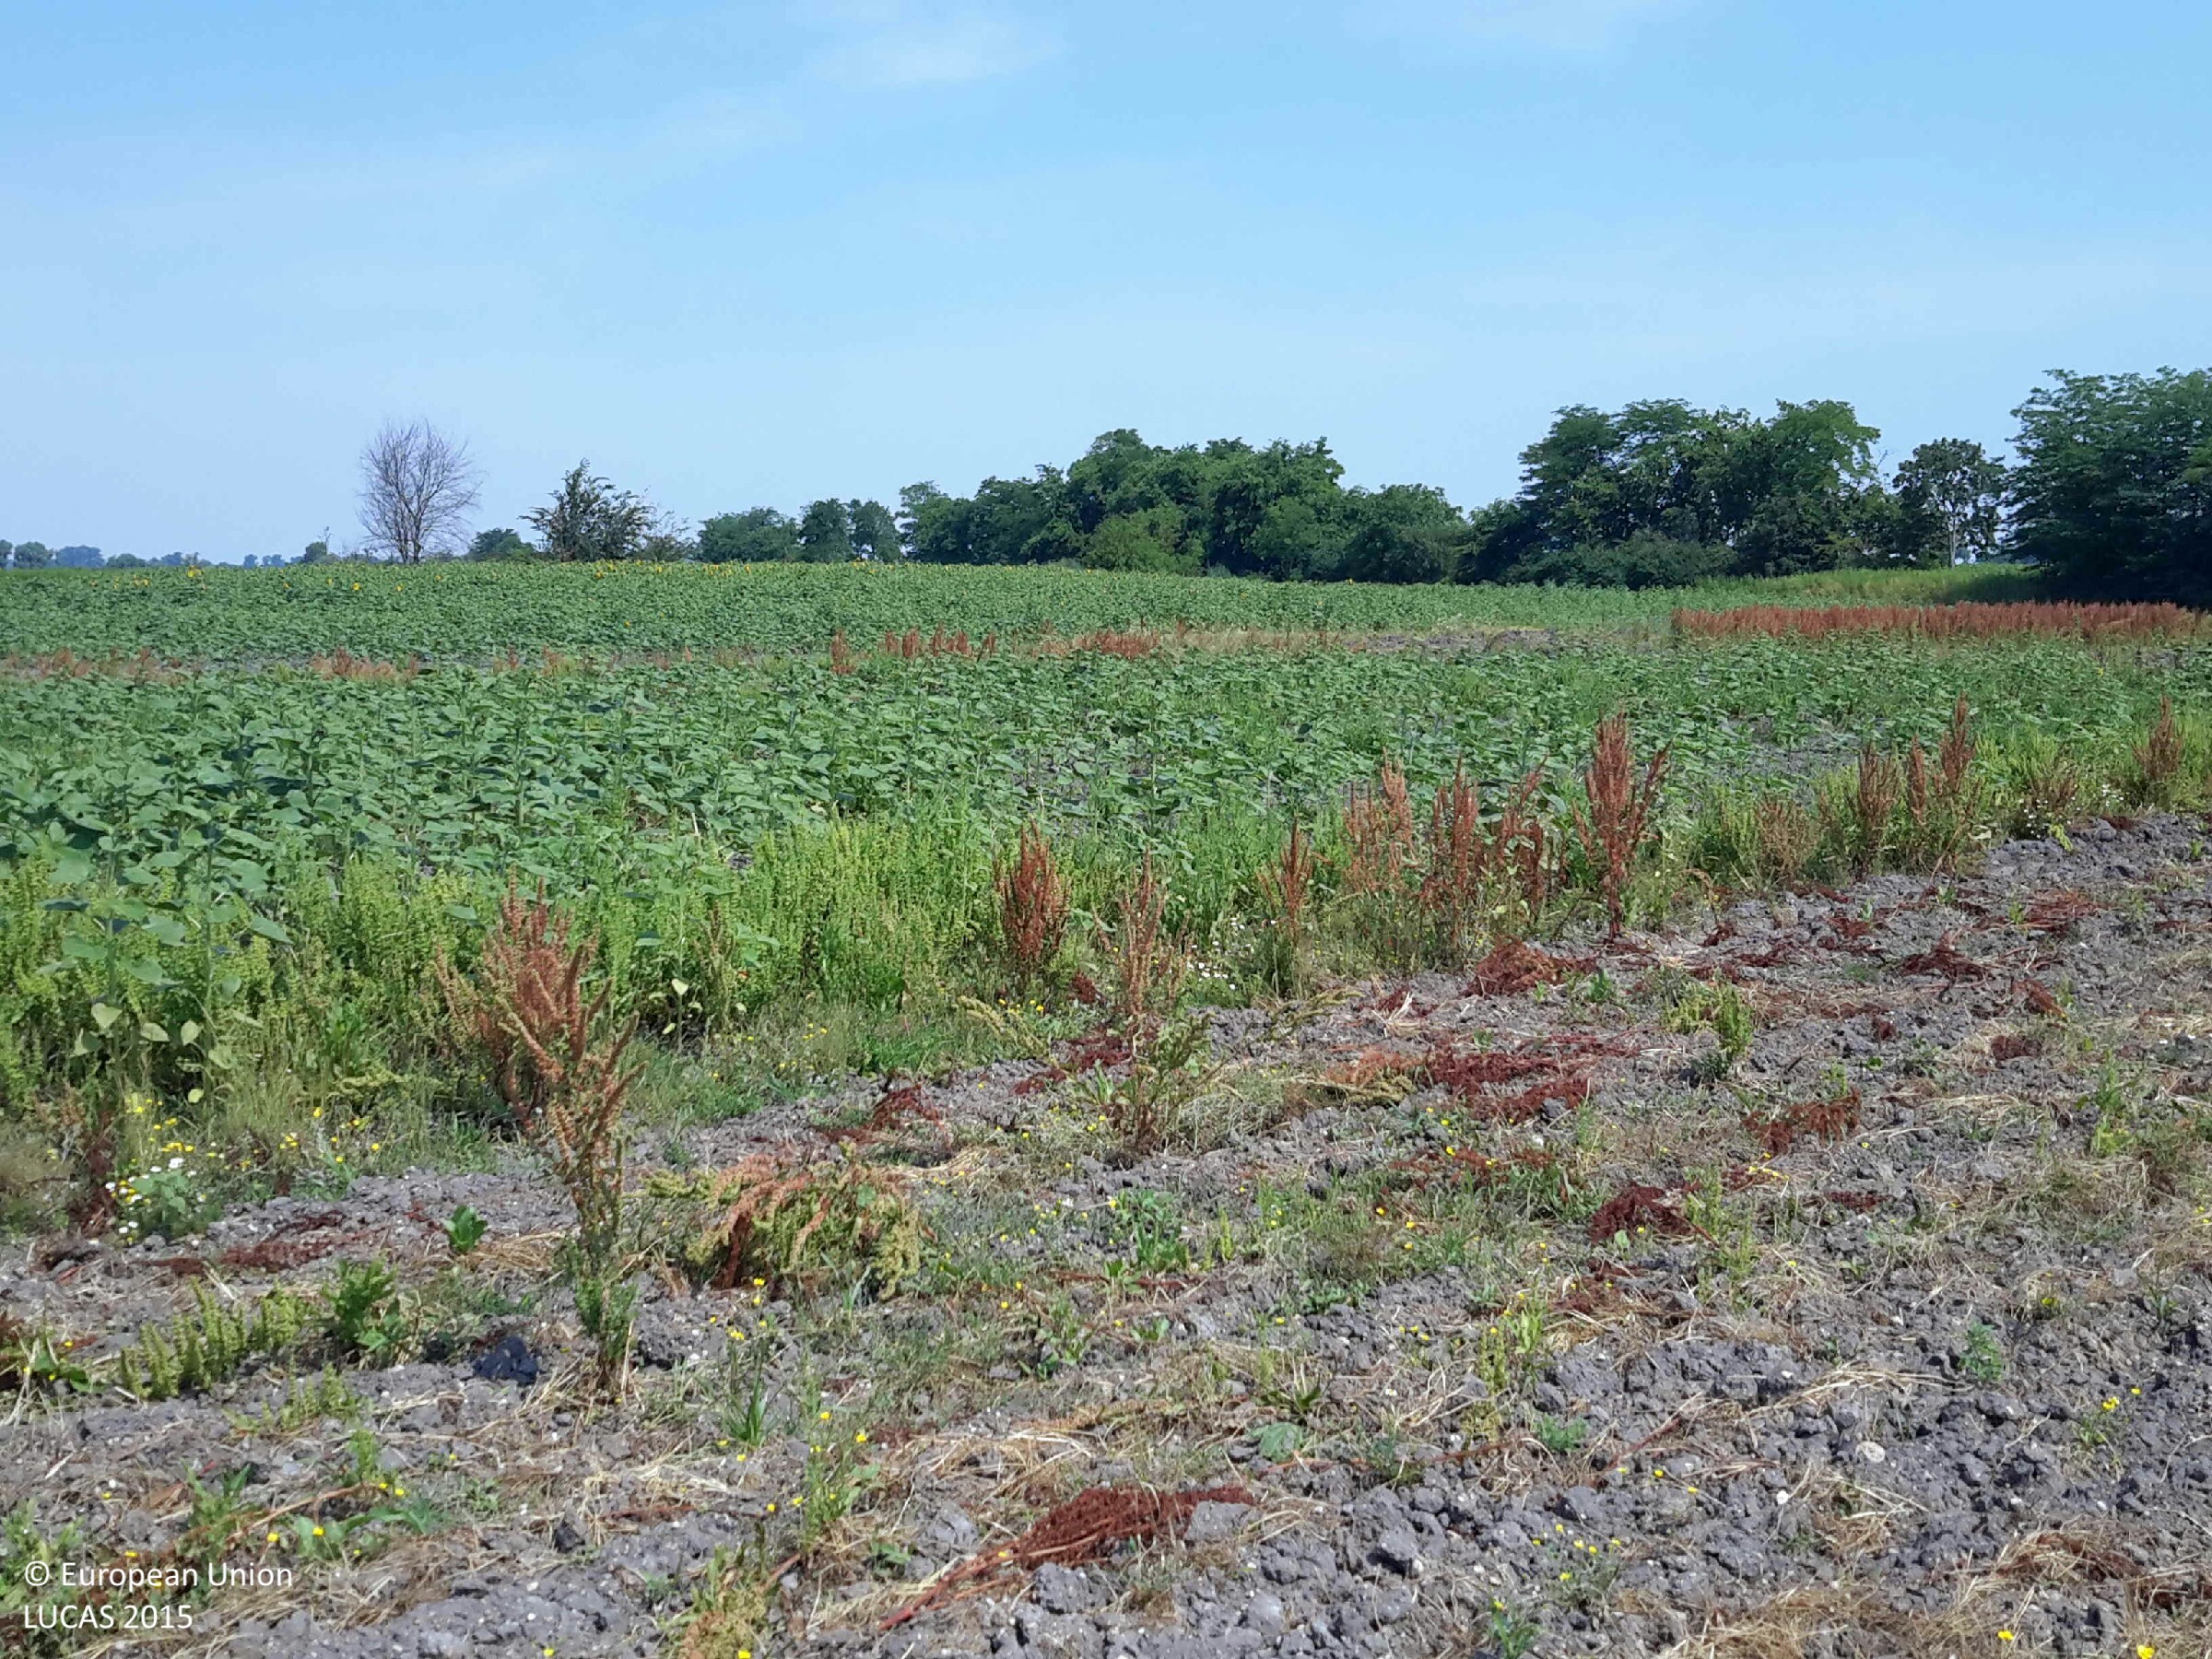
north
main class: Grassland
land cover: Spontaneously vegetated surfaces
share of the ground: 10 - 25 %
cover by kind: unconsolidated bare surface 90 %, herbaceous plants 10 %
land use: Fallow land
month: July
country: HU
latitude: 47.4313
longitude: 17.4186
